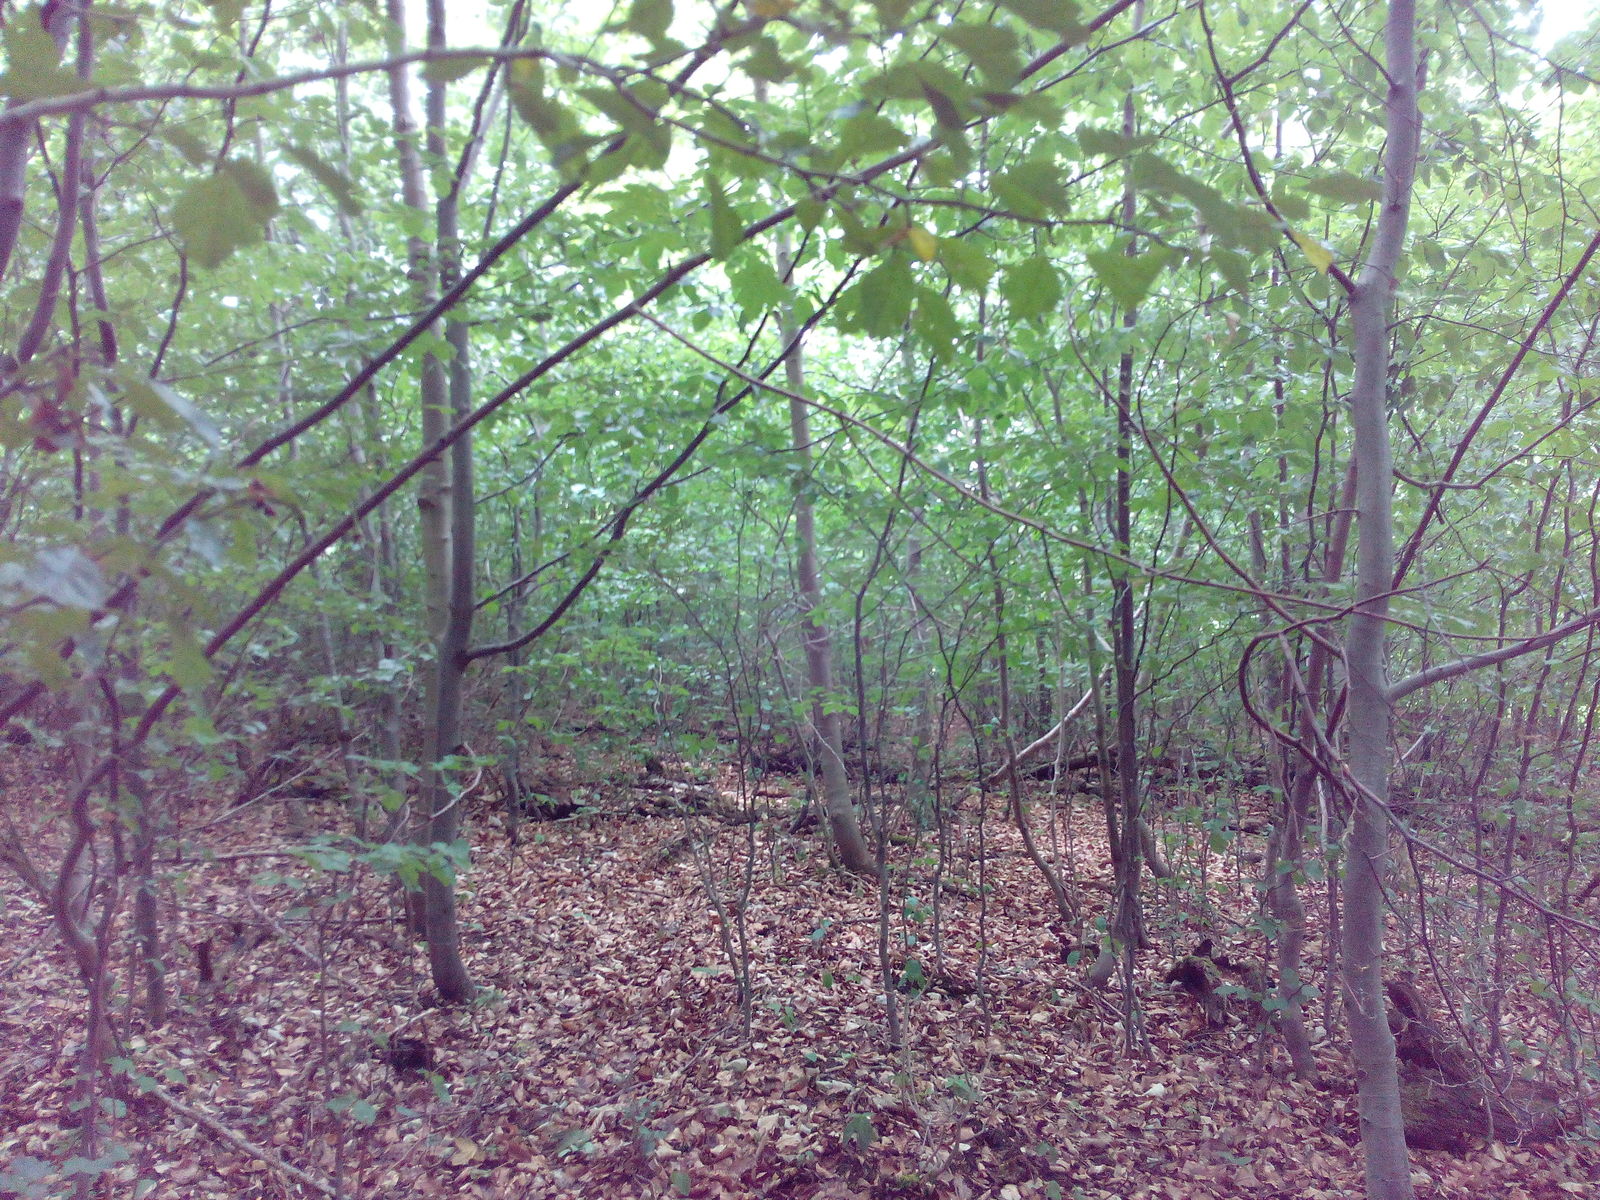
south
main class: Woodland
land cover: Broadleaved woodland
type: beech forest
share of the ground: > 75 %
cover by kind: broadleaved forest trees 100 %
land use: Forestry
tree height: > 5 m
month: July
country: DE
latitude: 50.7916
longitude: 10.9502
